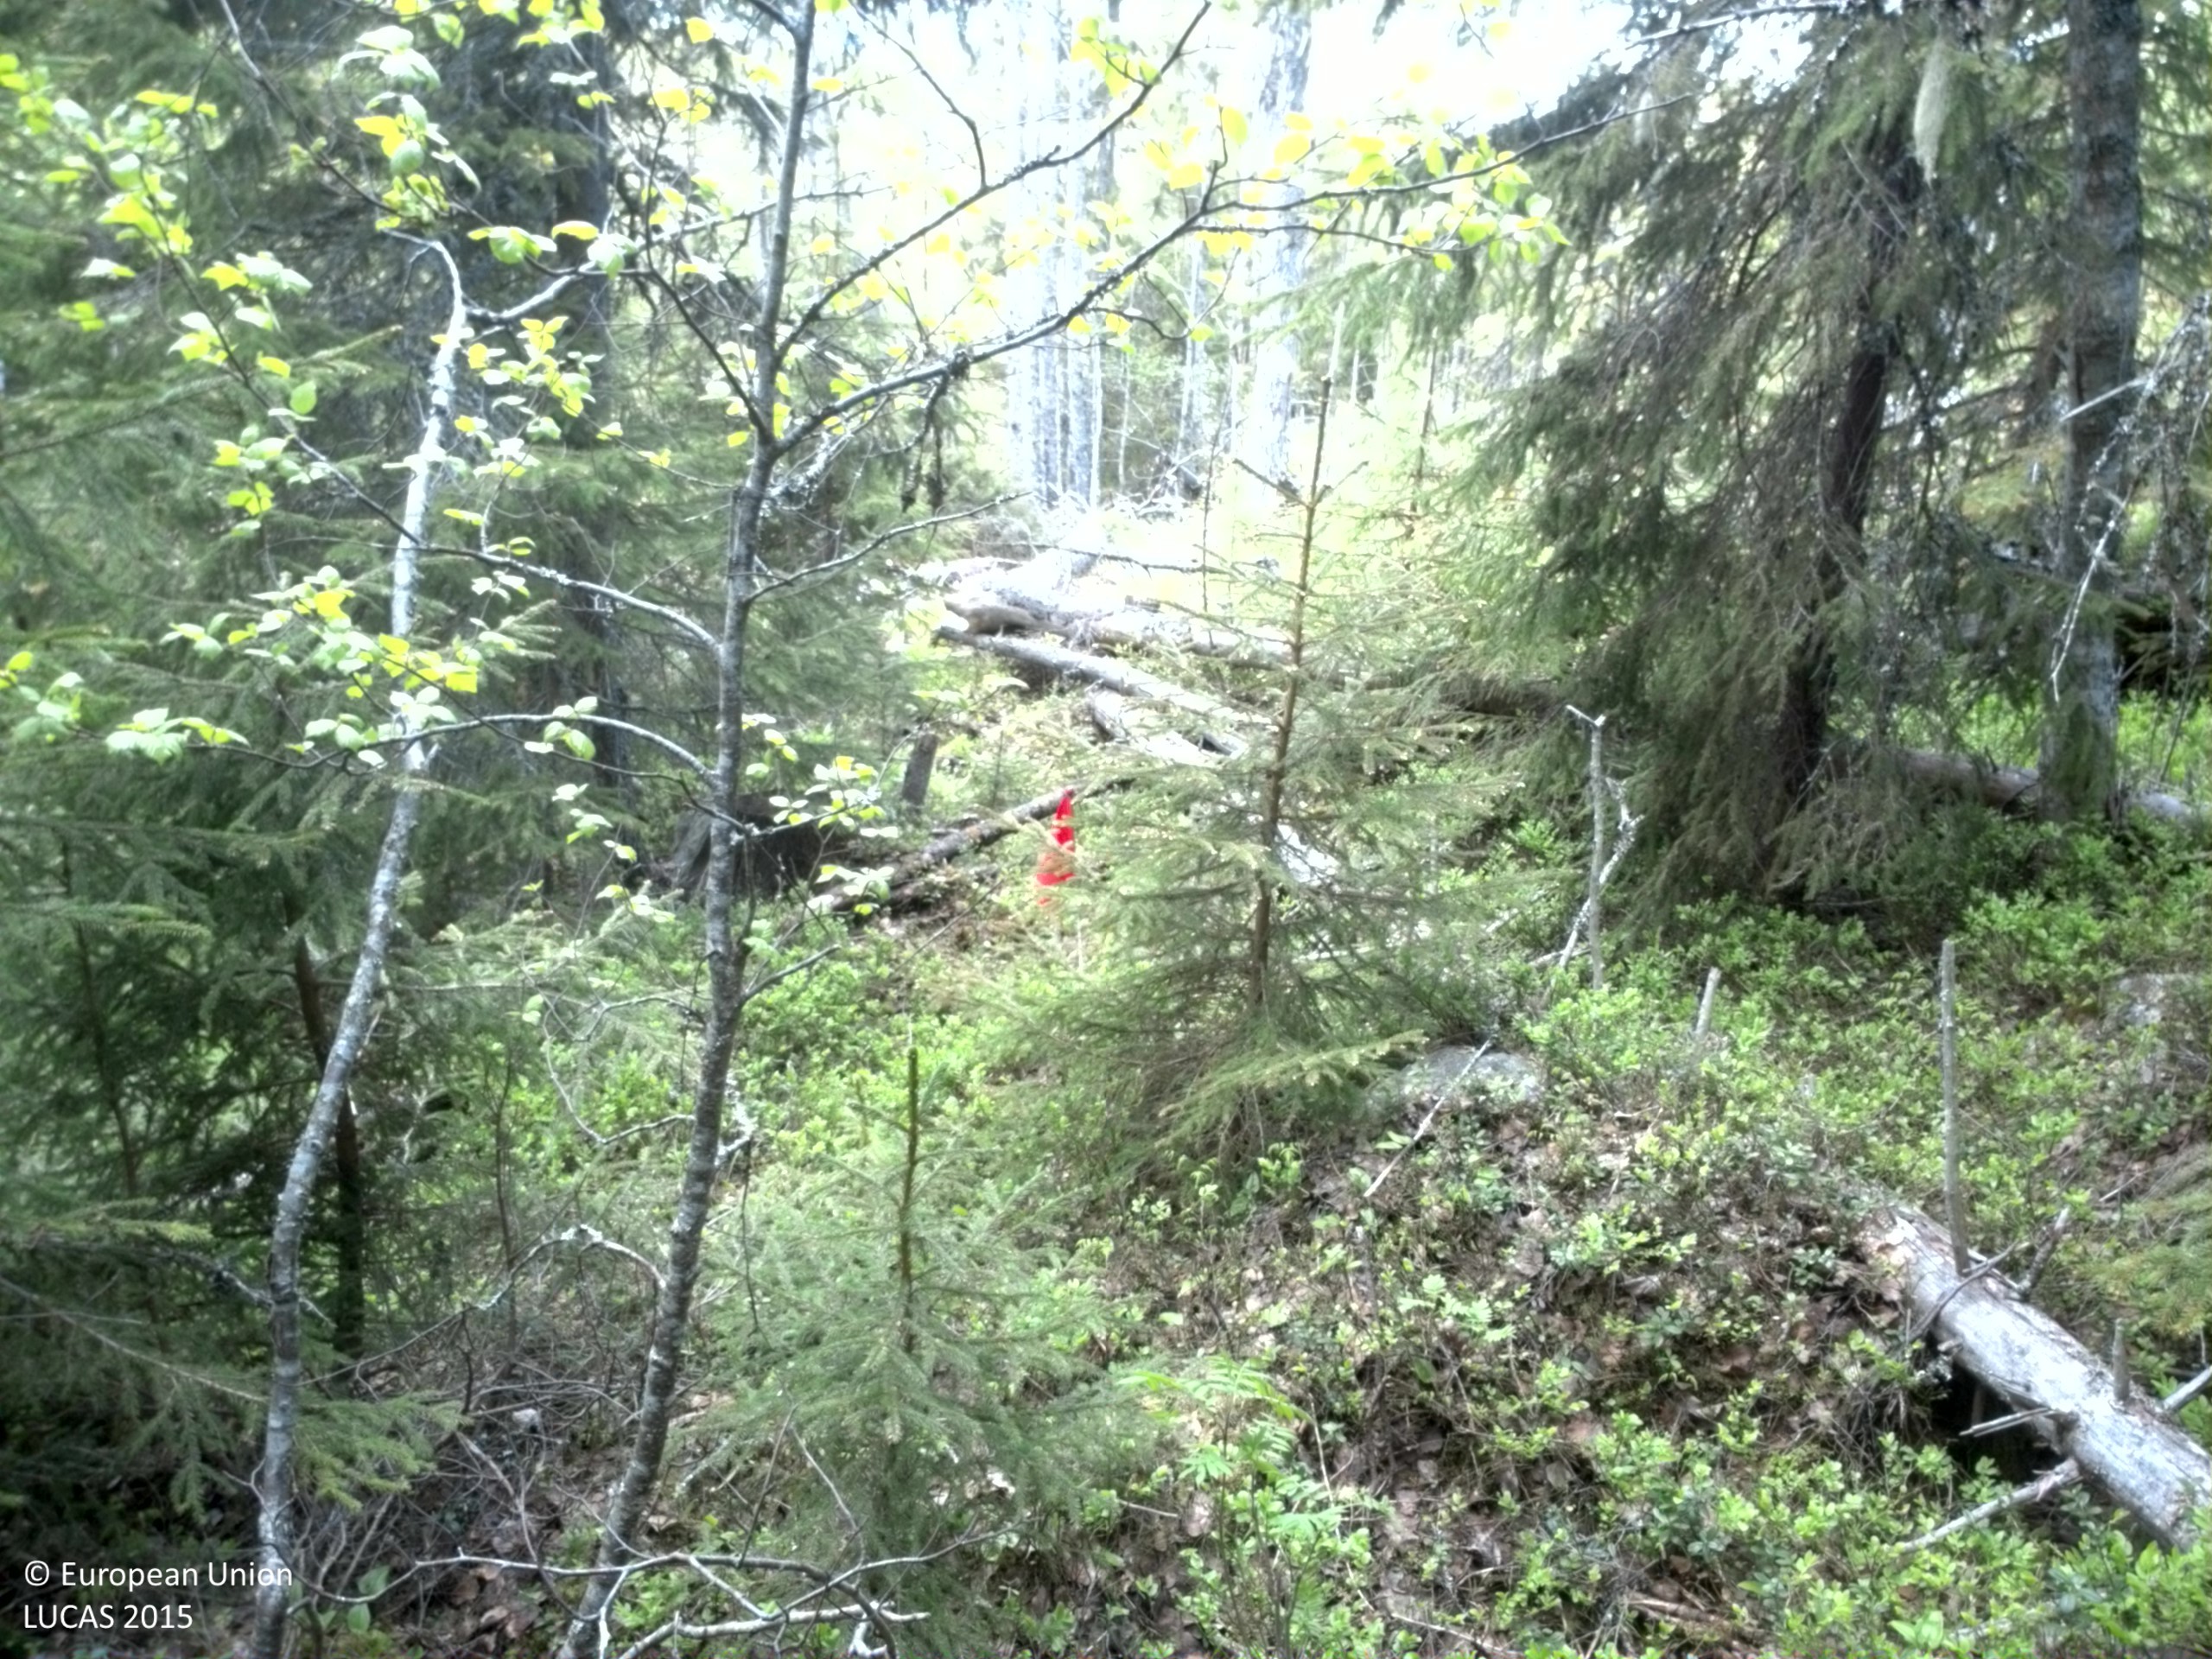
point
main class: Woodland
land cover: Spruce dominated coniferous woodland
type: boreal forest
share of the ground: > 75 %
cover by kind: coniferous forest trees 80 %, shrubs 15 %, herbaceous plants 5 %
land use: Forestry
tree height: > 5 m
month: June
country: SE
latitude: 62.9592
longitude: 17.3313
